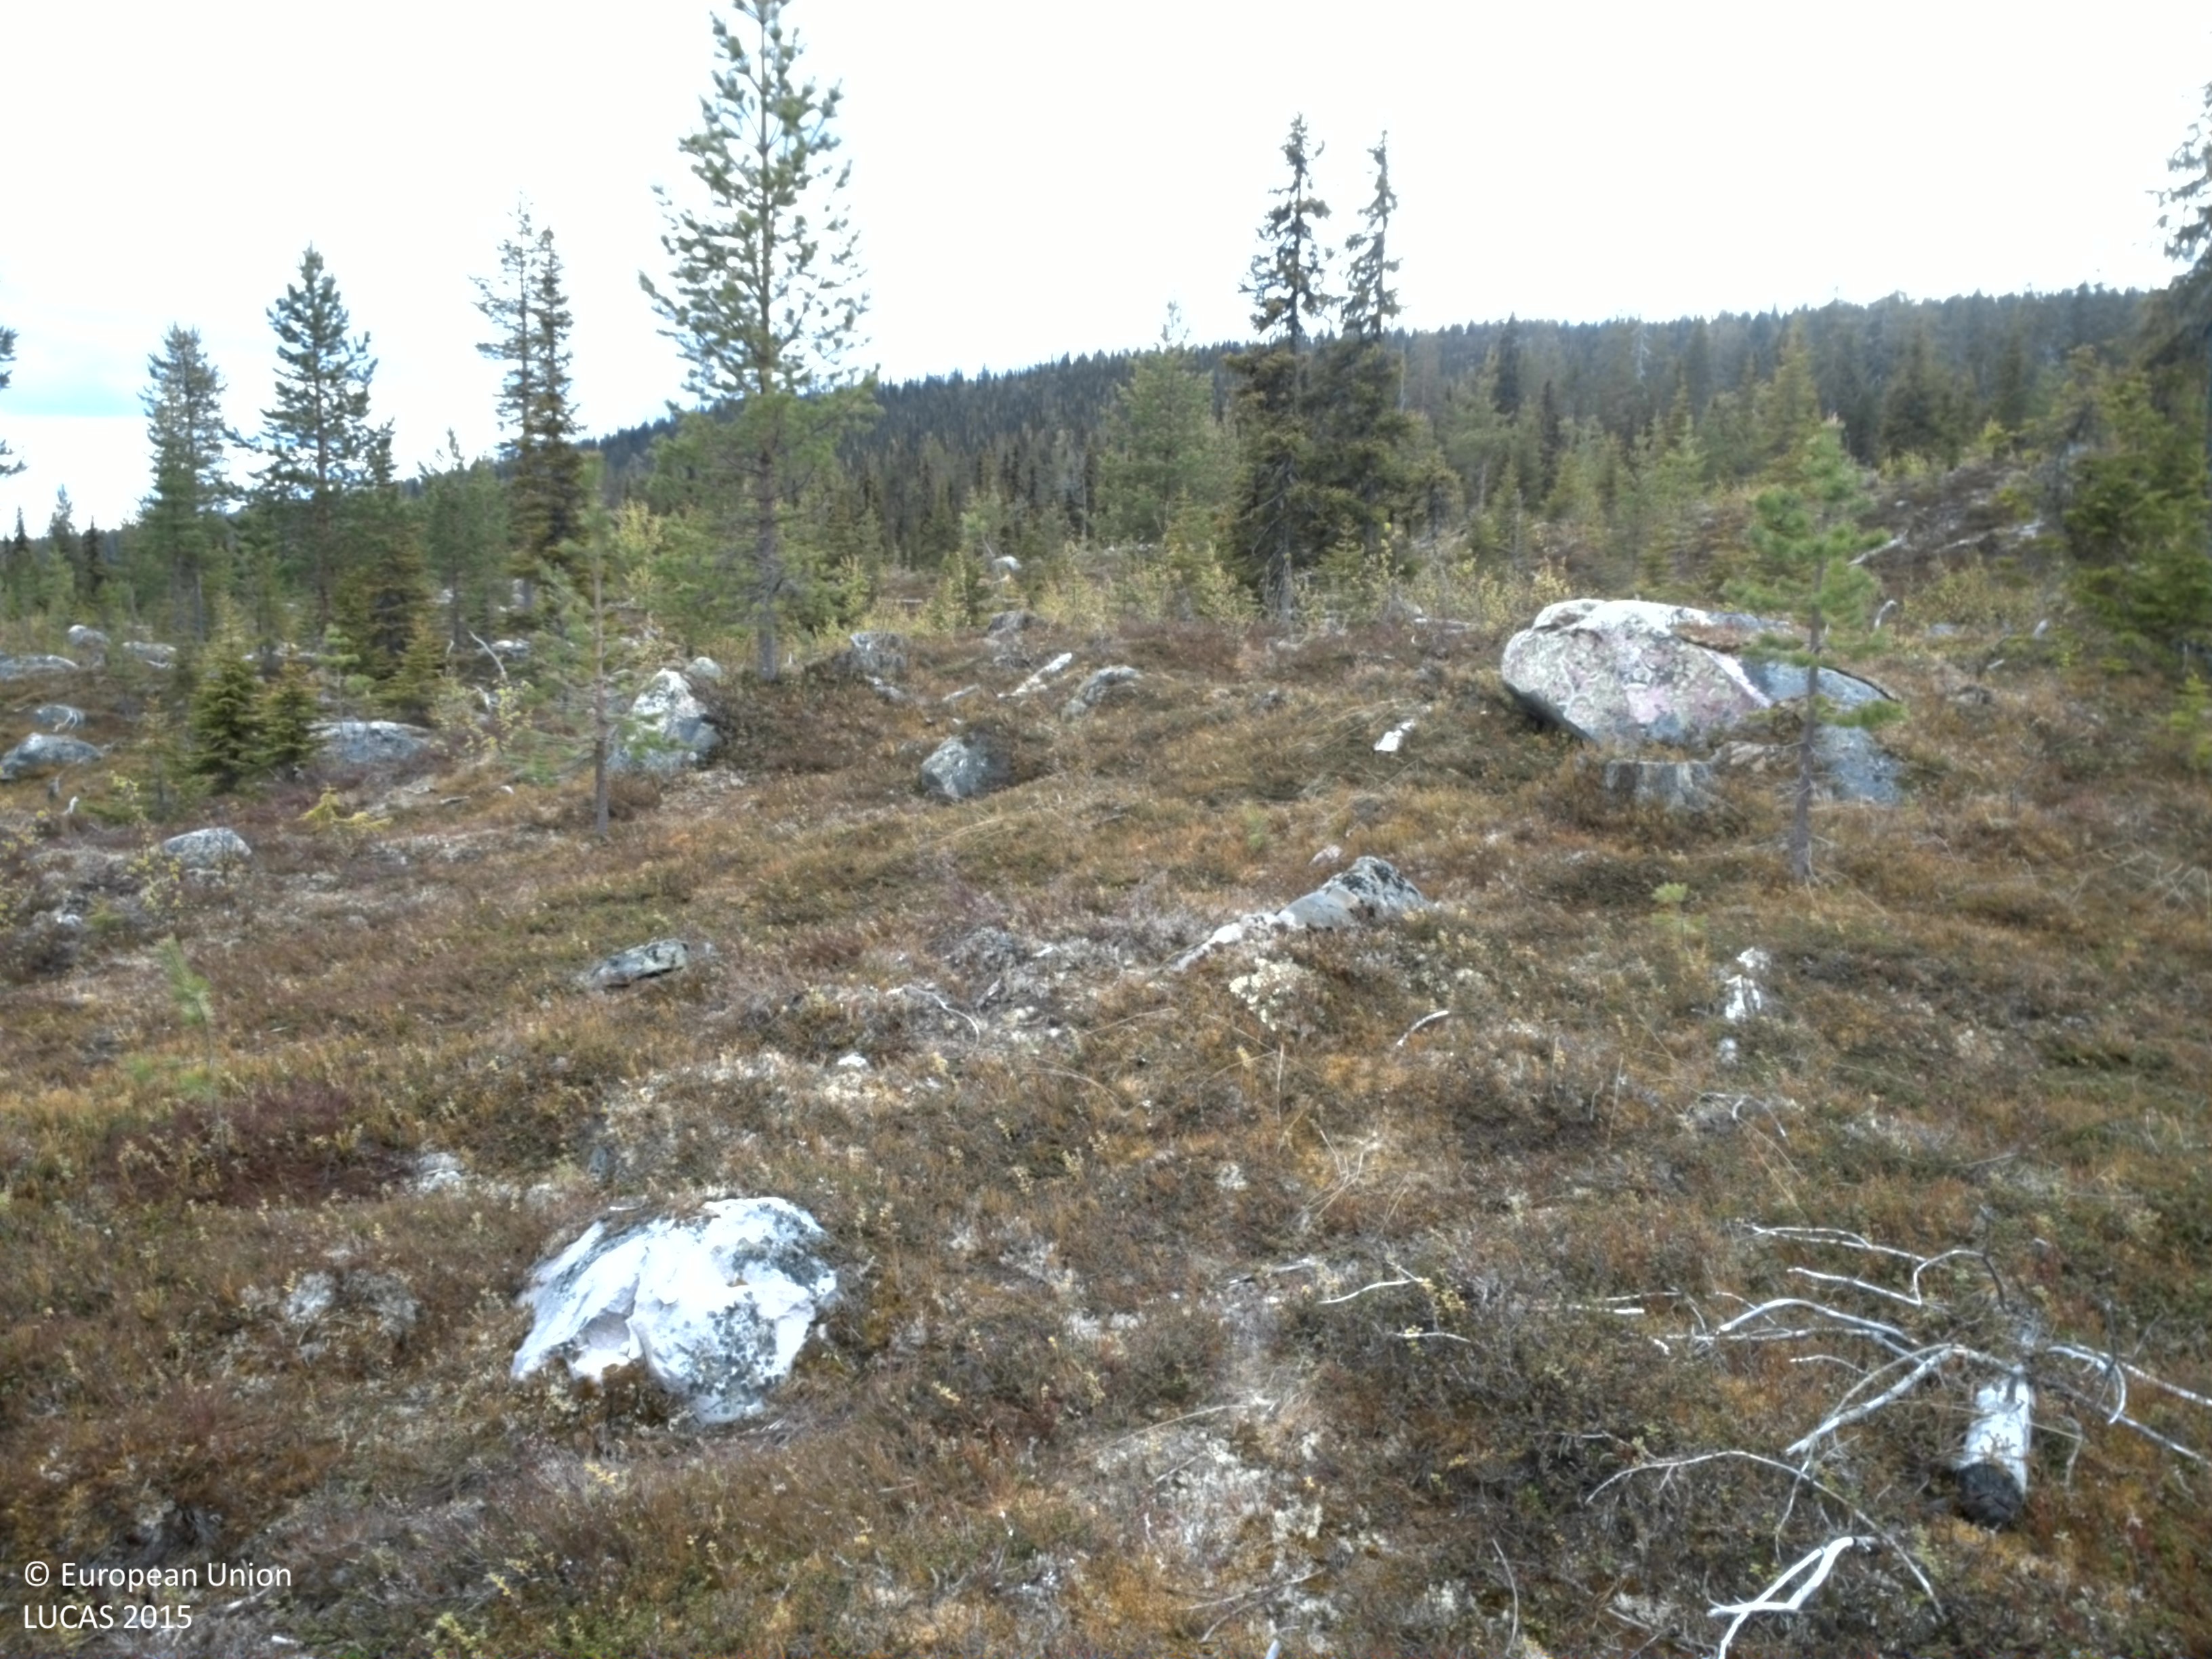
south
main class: Woodland
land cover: Spruce dominated mixed woodland
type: boreal forest
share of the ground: 10 - 25 %
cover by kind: shrubs 65 %, coniferous forest trees 15 %, consolidated bare surface 10 %, broadleaved forest trees 5 %, lichens and mosses 5 %
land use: Forestry
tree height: < 5 m
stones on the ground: > 50 %
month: June
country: SE
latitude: 66.0555
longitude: 18.6333
